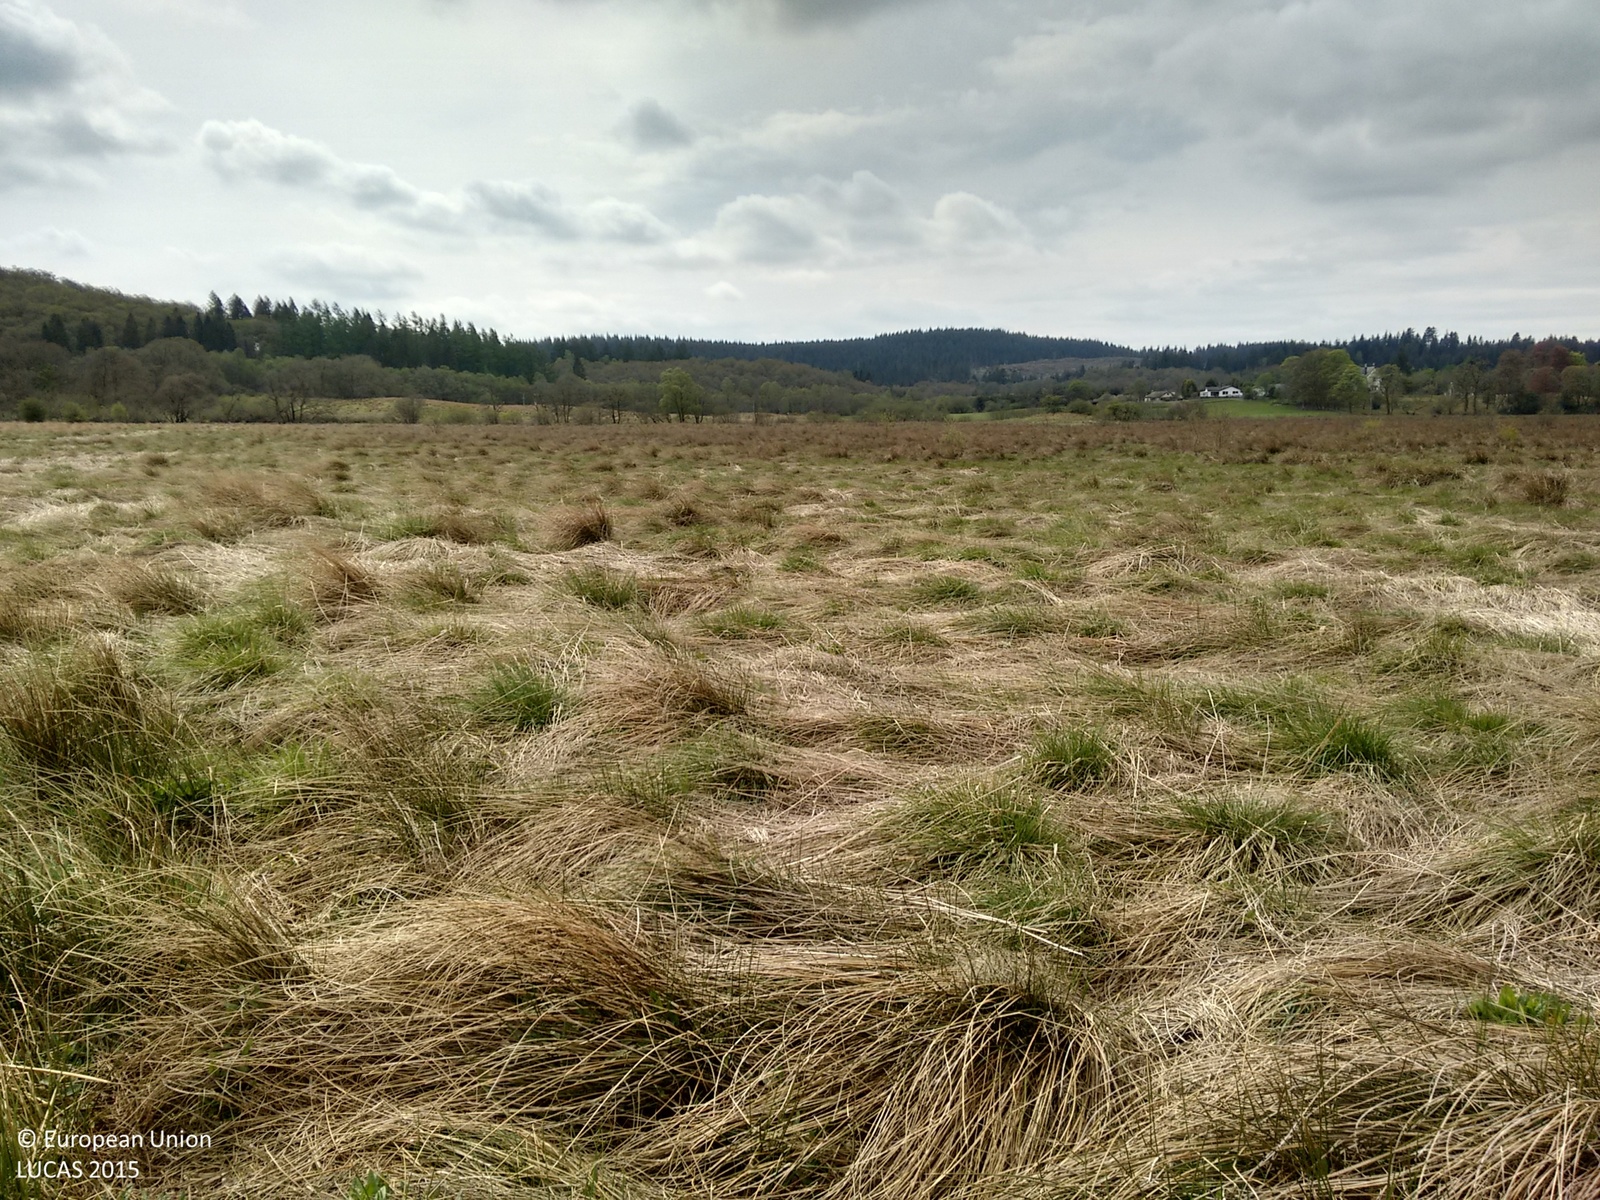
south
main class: Grassland
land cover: Grassland without tree/shrub cover
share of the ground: > 75 %
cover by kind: herbaceous plants 100 %
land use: Semi-natural and natural areas not in use
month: May
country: GB
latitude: 56.1767
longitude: -4.3829
